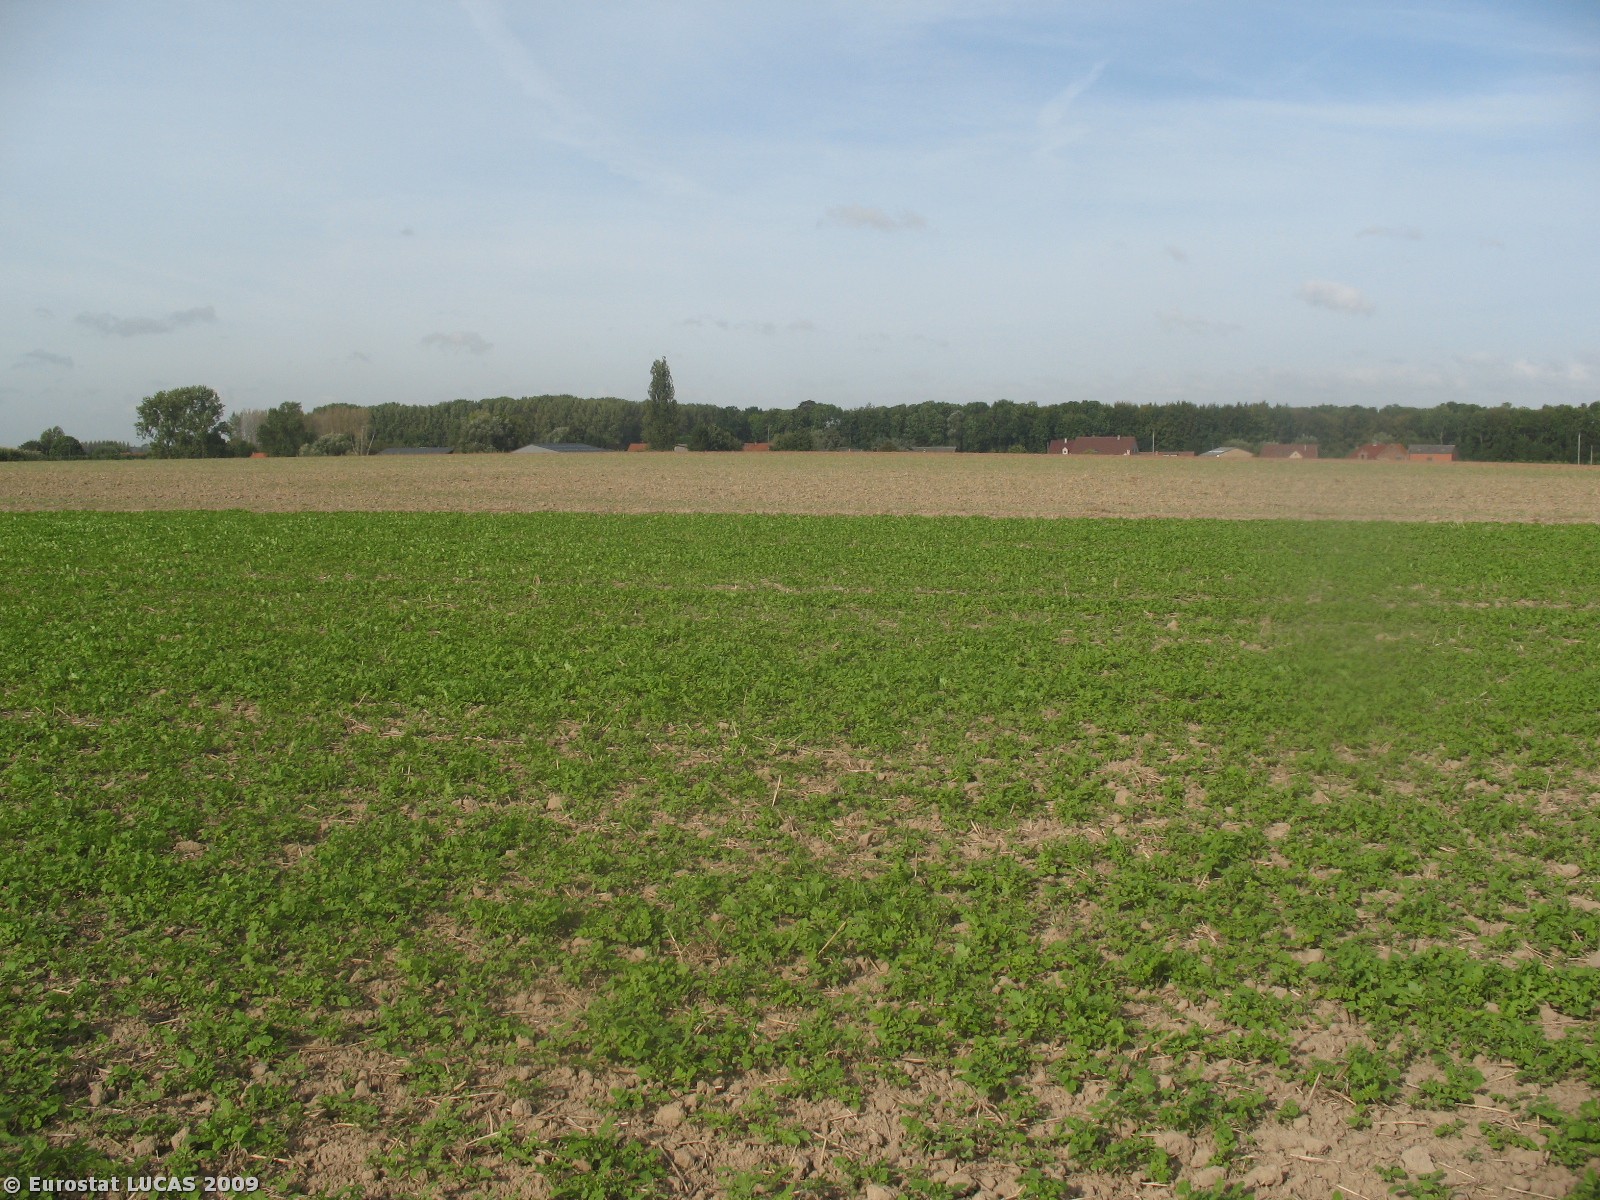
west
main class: Cropland
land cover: Other root crops
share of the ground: 50 - 75 %
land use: Agriculture (excluding fallow land and kitchen gardens)
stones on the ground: < 10 %
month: September
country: BE
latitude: 50.5594
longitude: 3.8532
